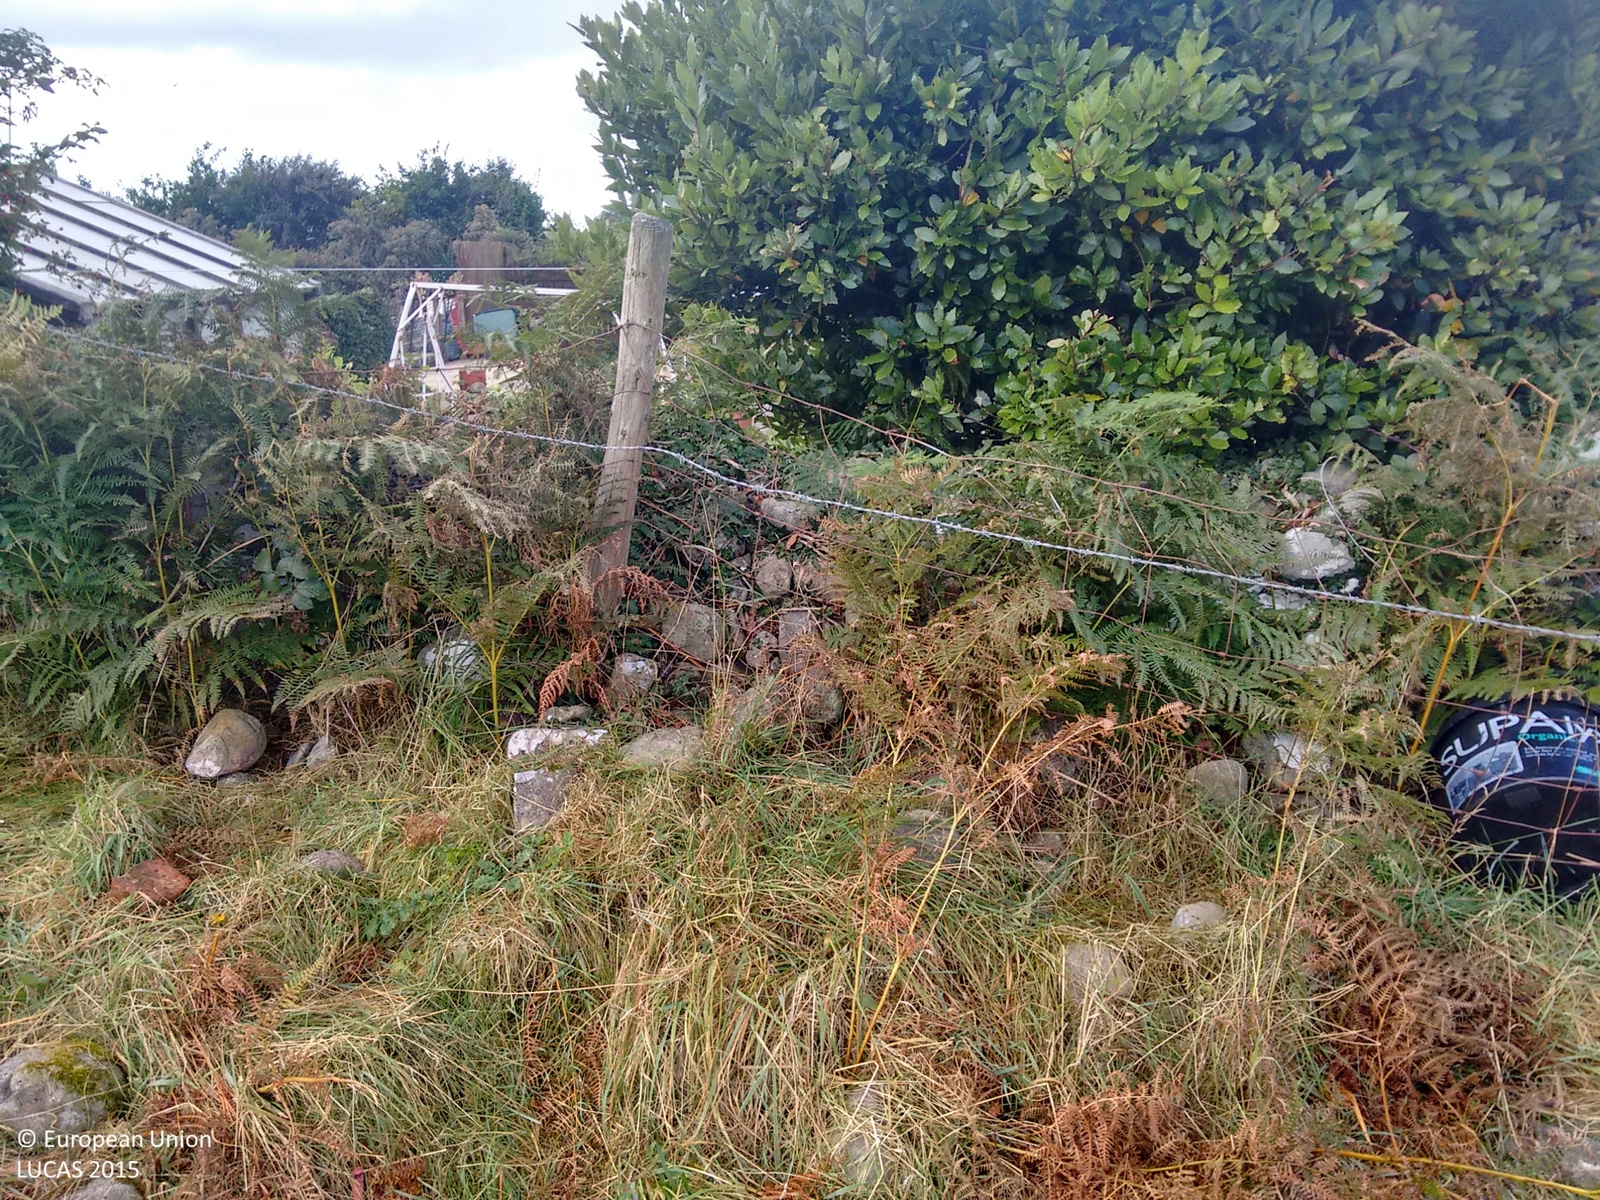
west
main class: Grassland
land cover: Grassland without tree/shrub cover
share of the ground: > 75 %
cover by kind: herbaceous plants 100 %
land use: Agriculture (excluding fallow land and kitchen gardens)
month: October
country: GB
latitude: 52.7893
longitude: -4.1096
